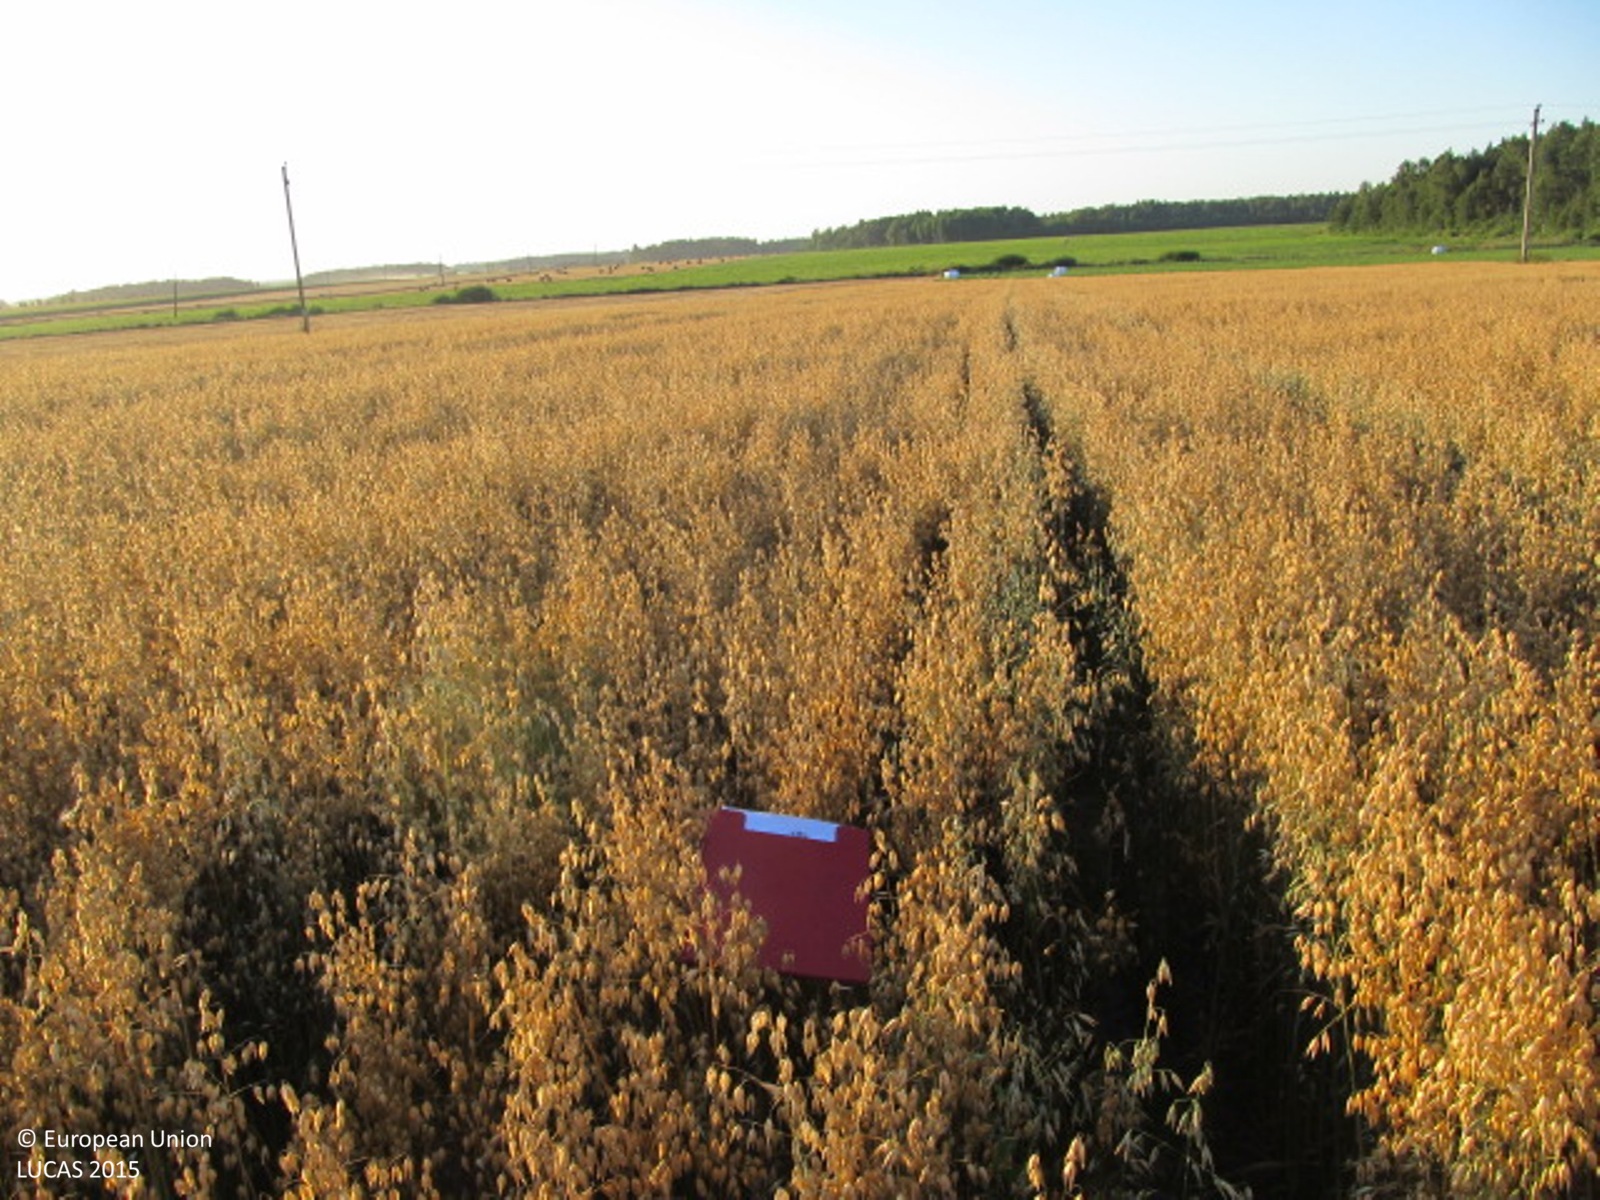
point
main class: Cropland
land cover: Oats
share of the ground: > 75 %
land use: Agriculture (excluding fallow land and kitchen gardens)
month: August
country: LT
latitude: 56.2352
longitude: 22.9892
